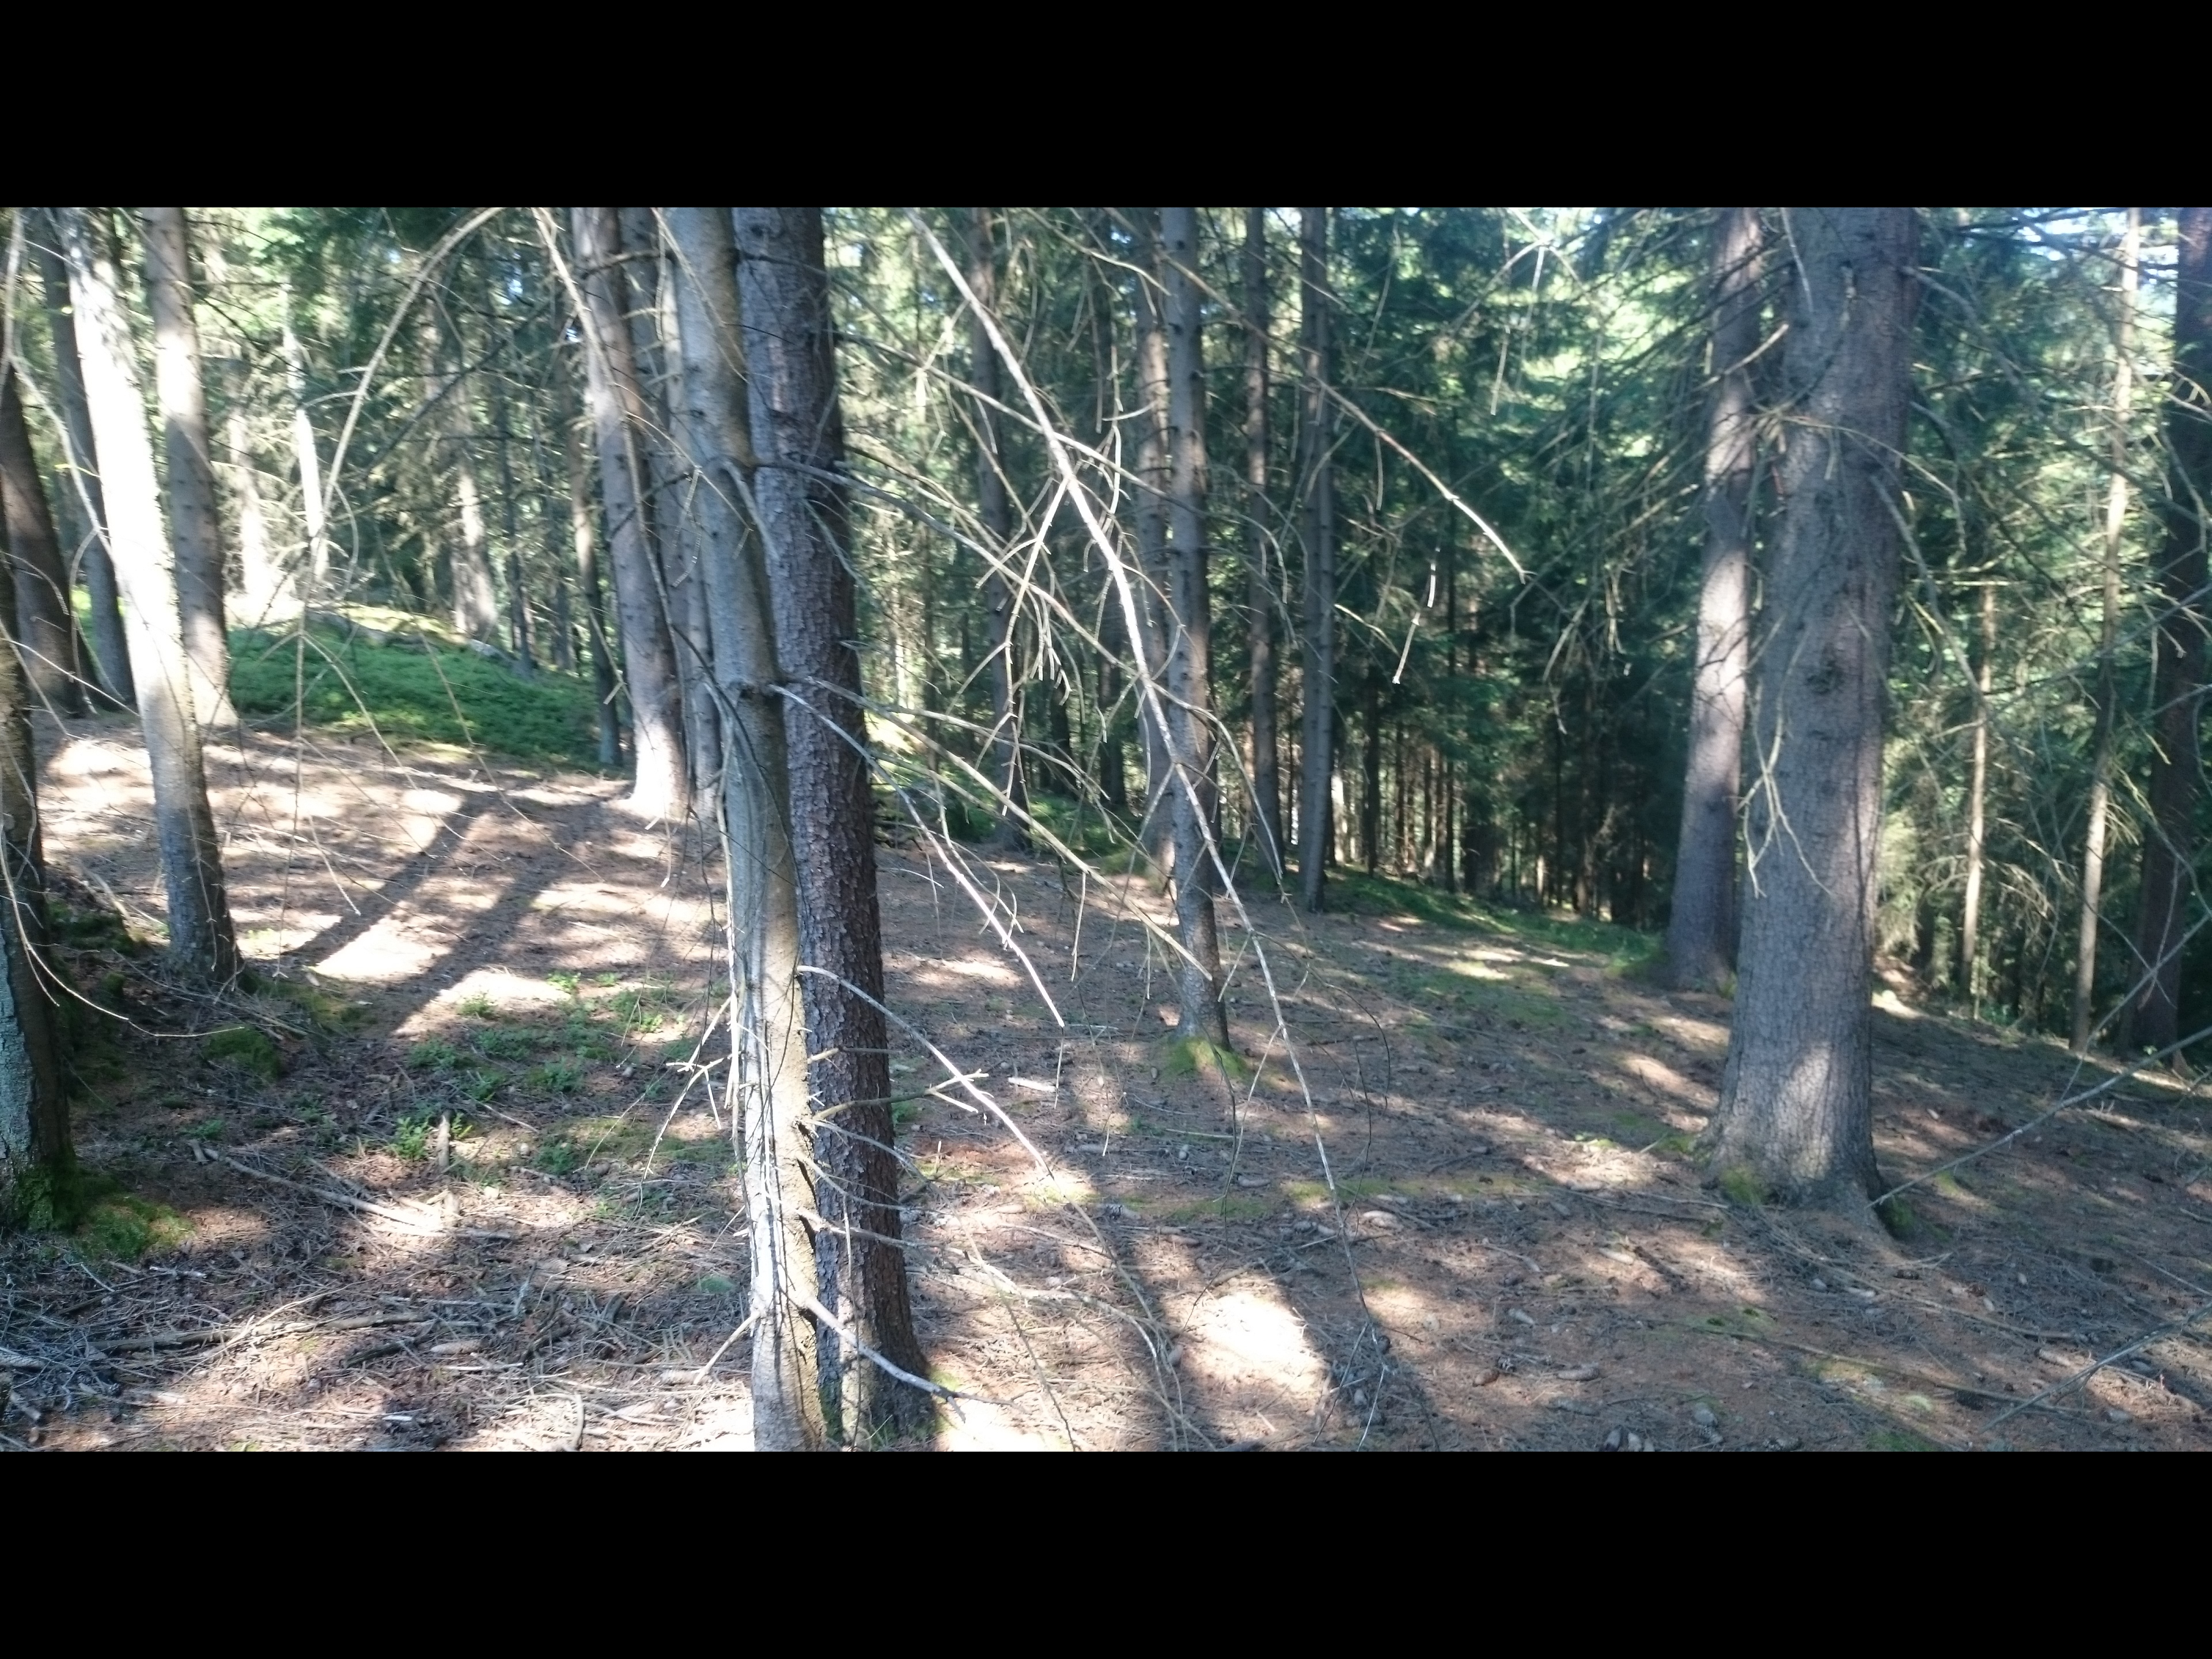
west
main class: Woodland
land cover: Spruce dominated coniferous woodland
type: hemiboreal forest and nemoral coniferous forest and mixed broadleaved-coniferous forest
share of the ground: > 75 %
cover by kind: coniferous forest trees 75 %, unconsolidated bare surface 20 %, shrubs 5 %
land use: Forestry
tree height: > 5 m
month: June
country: AT
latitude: 48.4504
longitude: 14.6384
